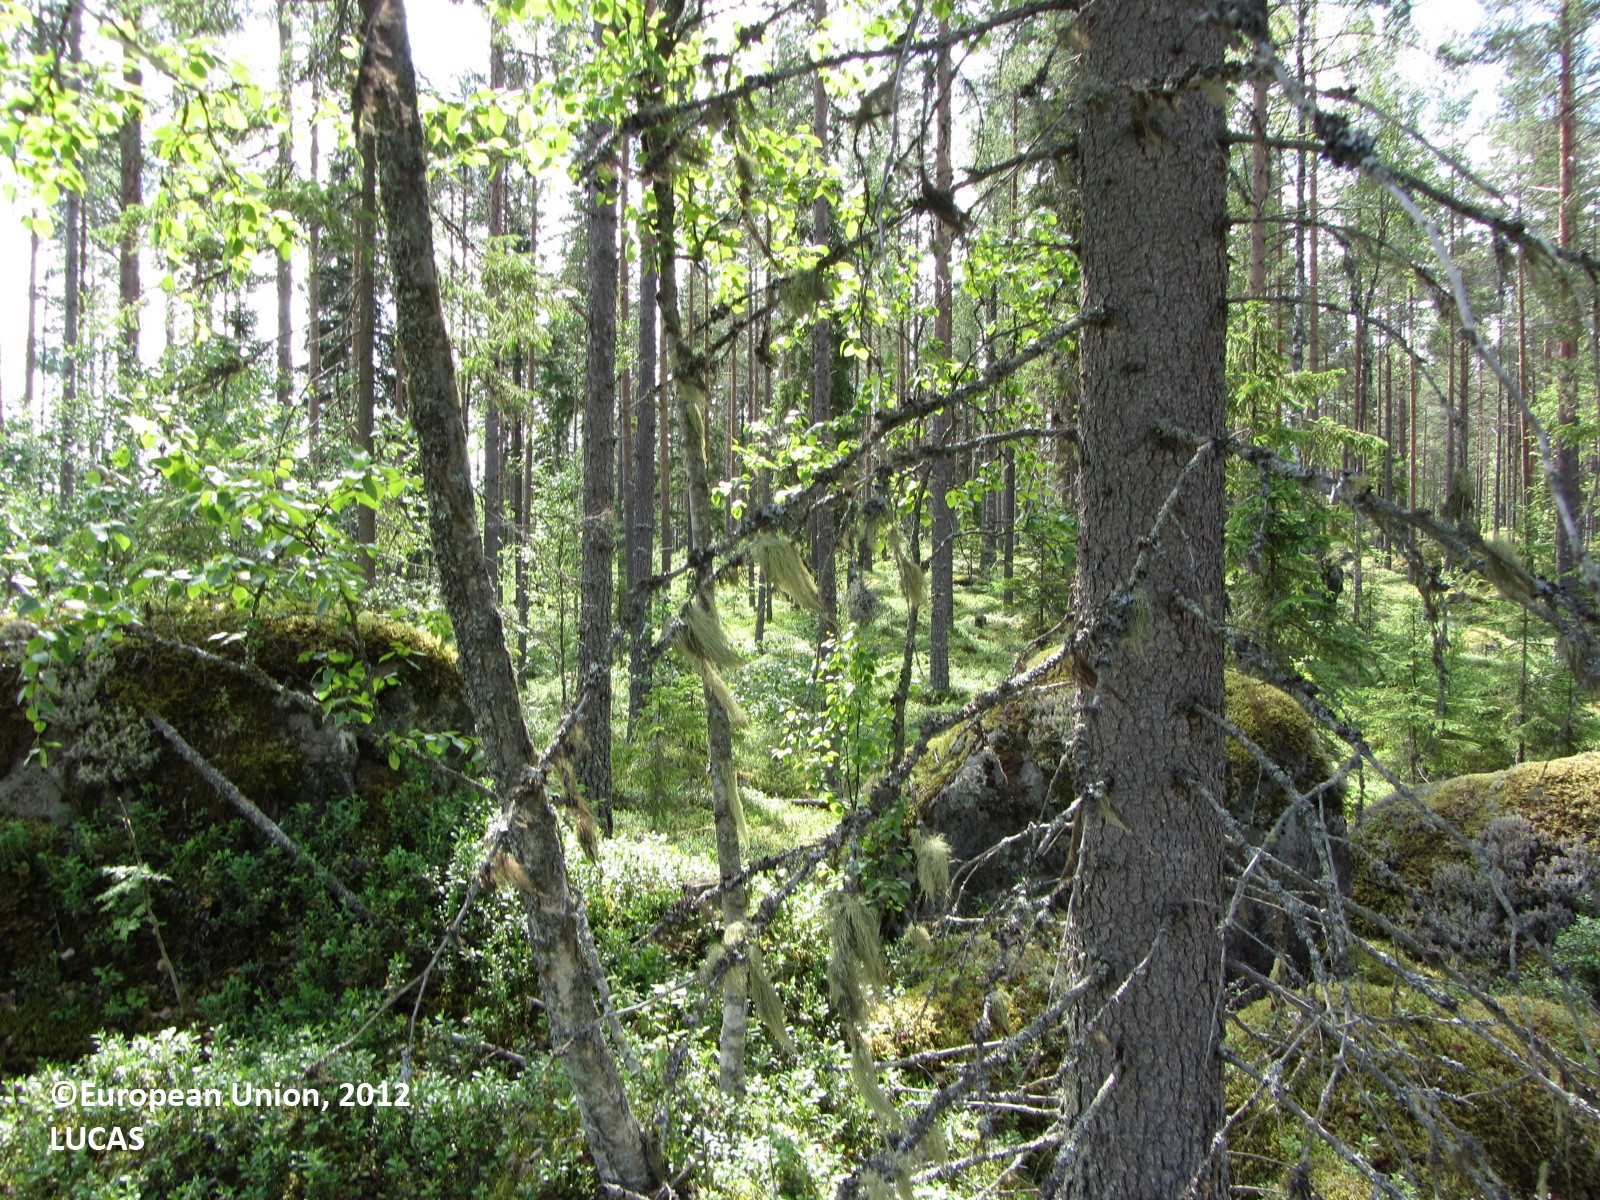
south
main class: Woodland
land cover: Pine dominated coniferous woodland
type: boreal forest
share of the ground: 50 - 75 %
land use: Forestry
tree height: > 5 m
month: July
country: FI
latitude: 63.6730
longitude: 25.4375
